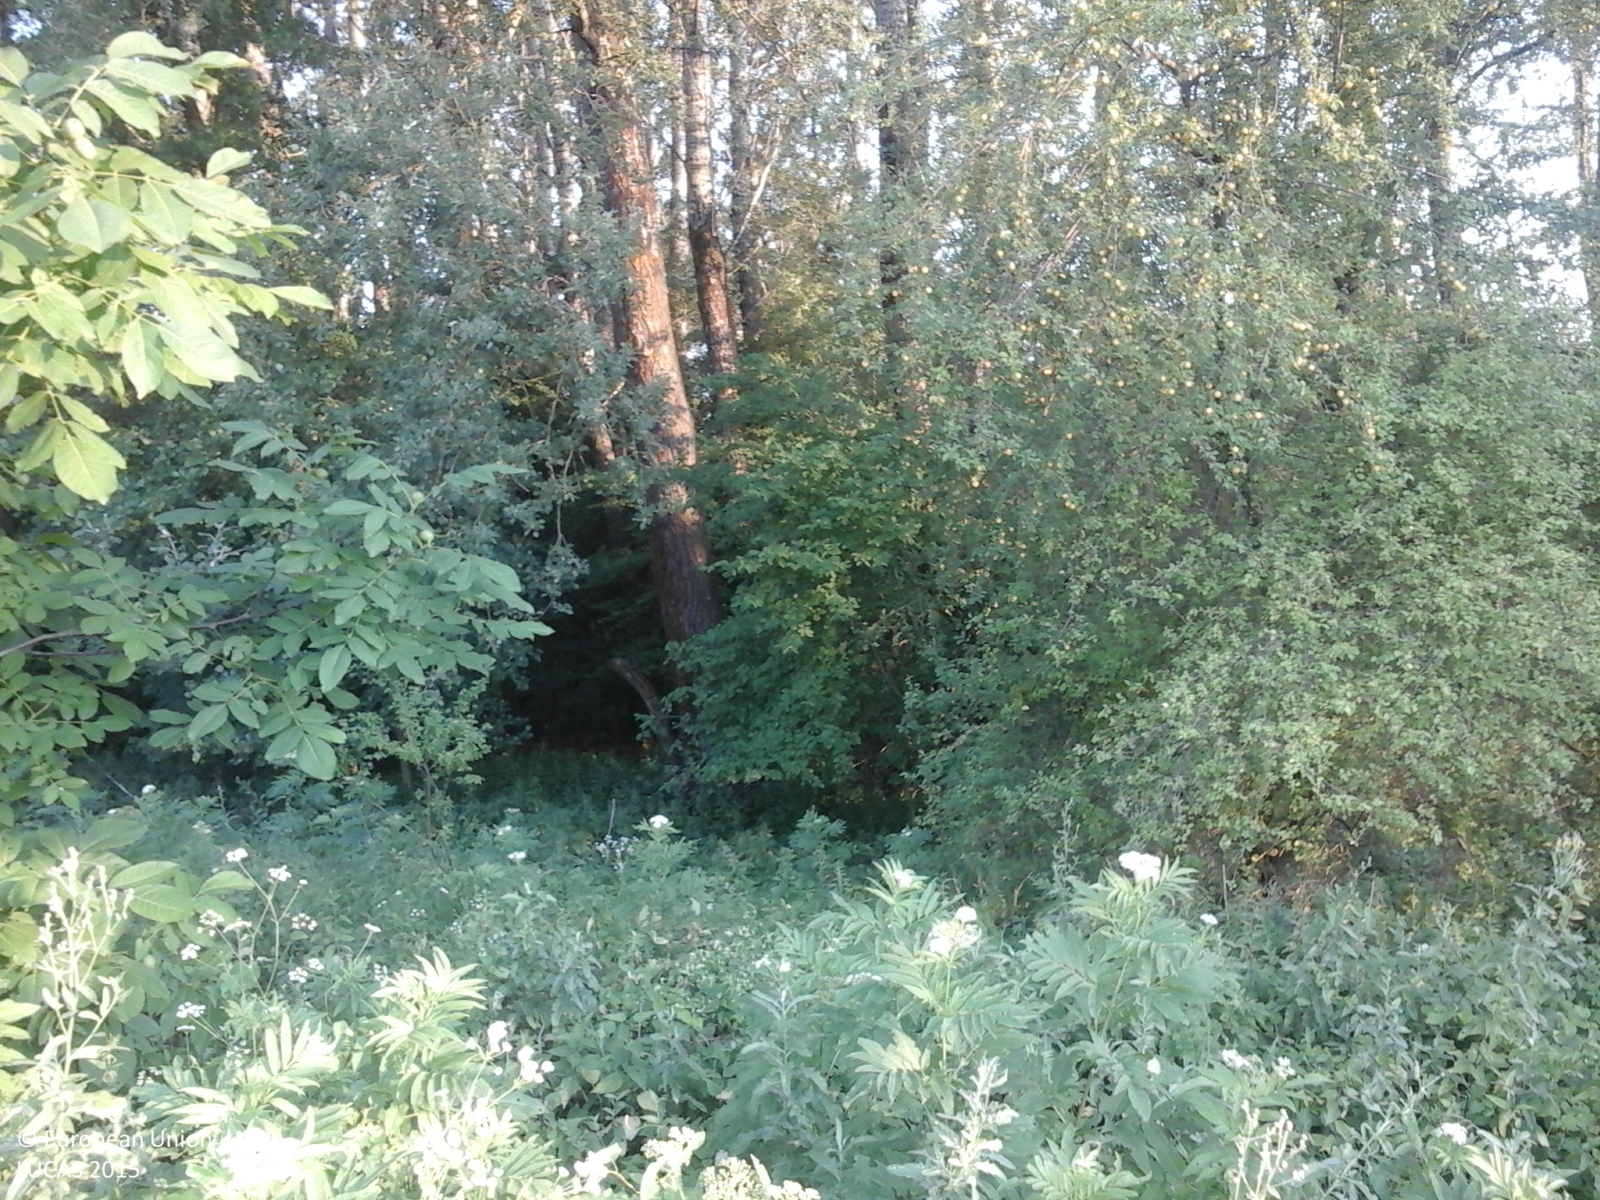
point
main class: Woodland
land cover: Broadleaved woodland
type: non-riverine alder, birch or aspen forest
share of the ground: > 75 %
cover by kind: broadleaved forest trees 100 %
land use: Forestry
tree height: > 5 m
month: July
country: RO
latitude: 44.7017
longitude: 25.6068
